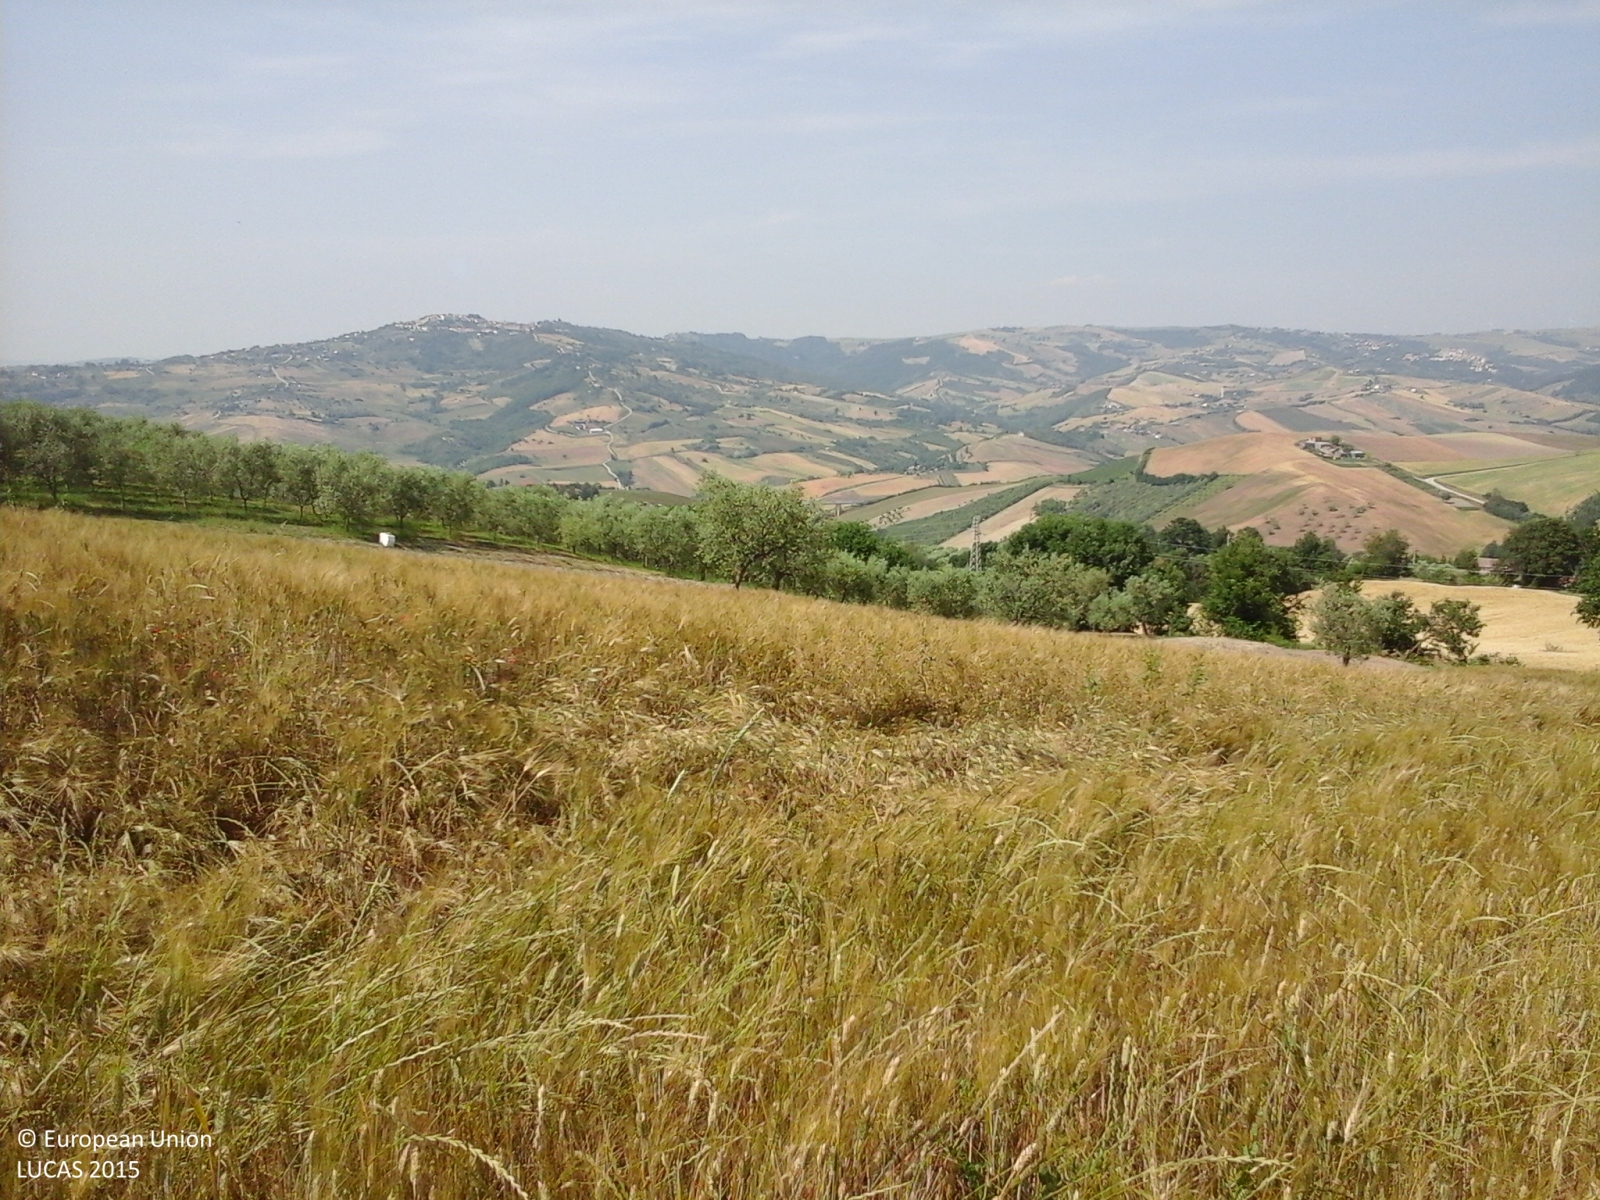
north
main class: Cropland
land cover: Durum wheat
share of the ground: > 75 %
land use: Agriculture (excluding fallow land and kitchen gardens)
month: June
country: IT
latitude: 41.0742
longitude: 15.1581
